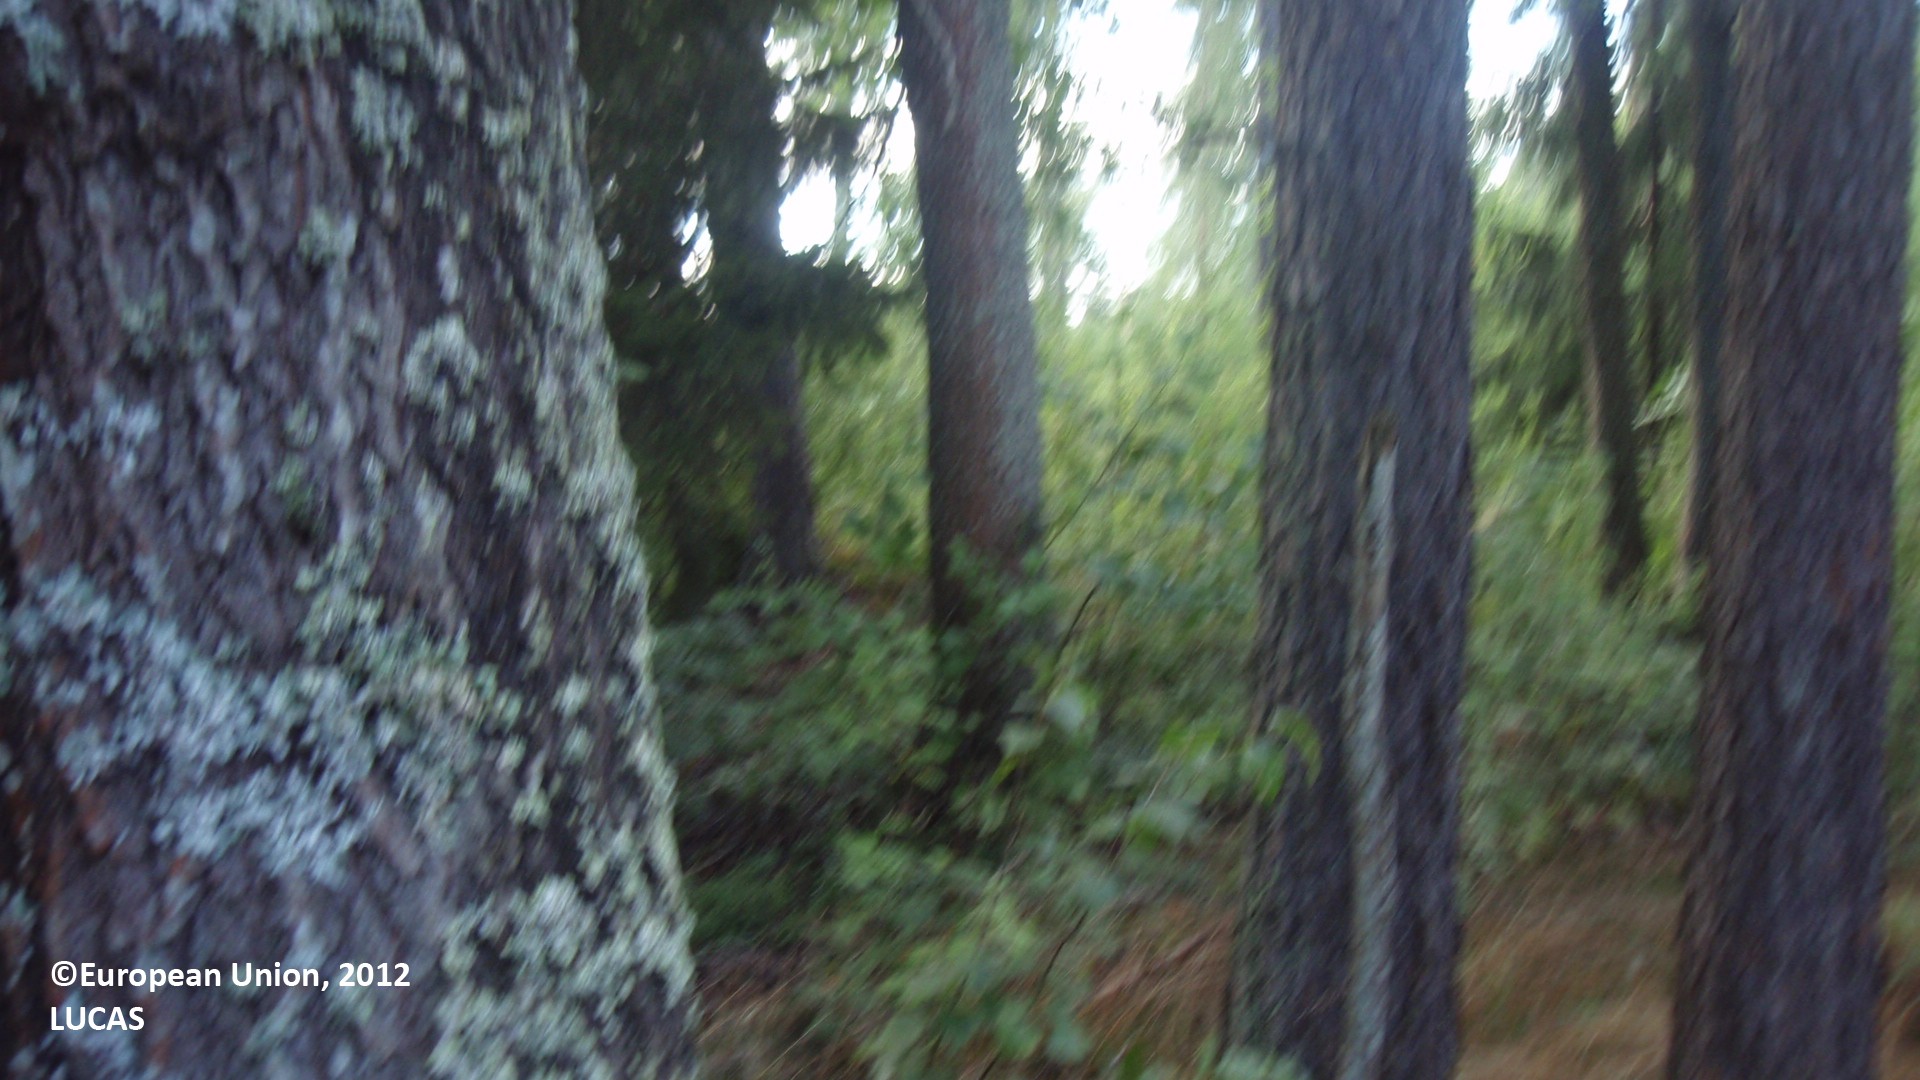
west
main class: Woodland
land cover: Pine dominated mixed woodland
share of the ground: 50 - 75 %
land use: Forestry
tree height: > 5 m
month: August
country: FI
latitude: 60.6152
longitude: 26.6954
